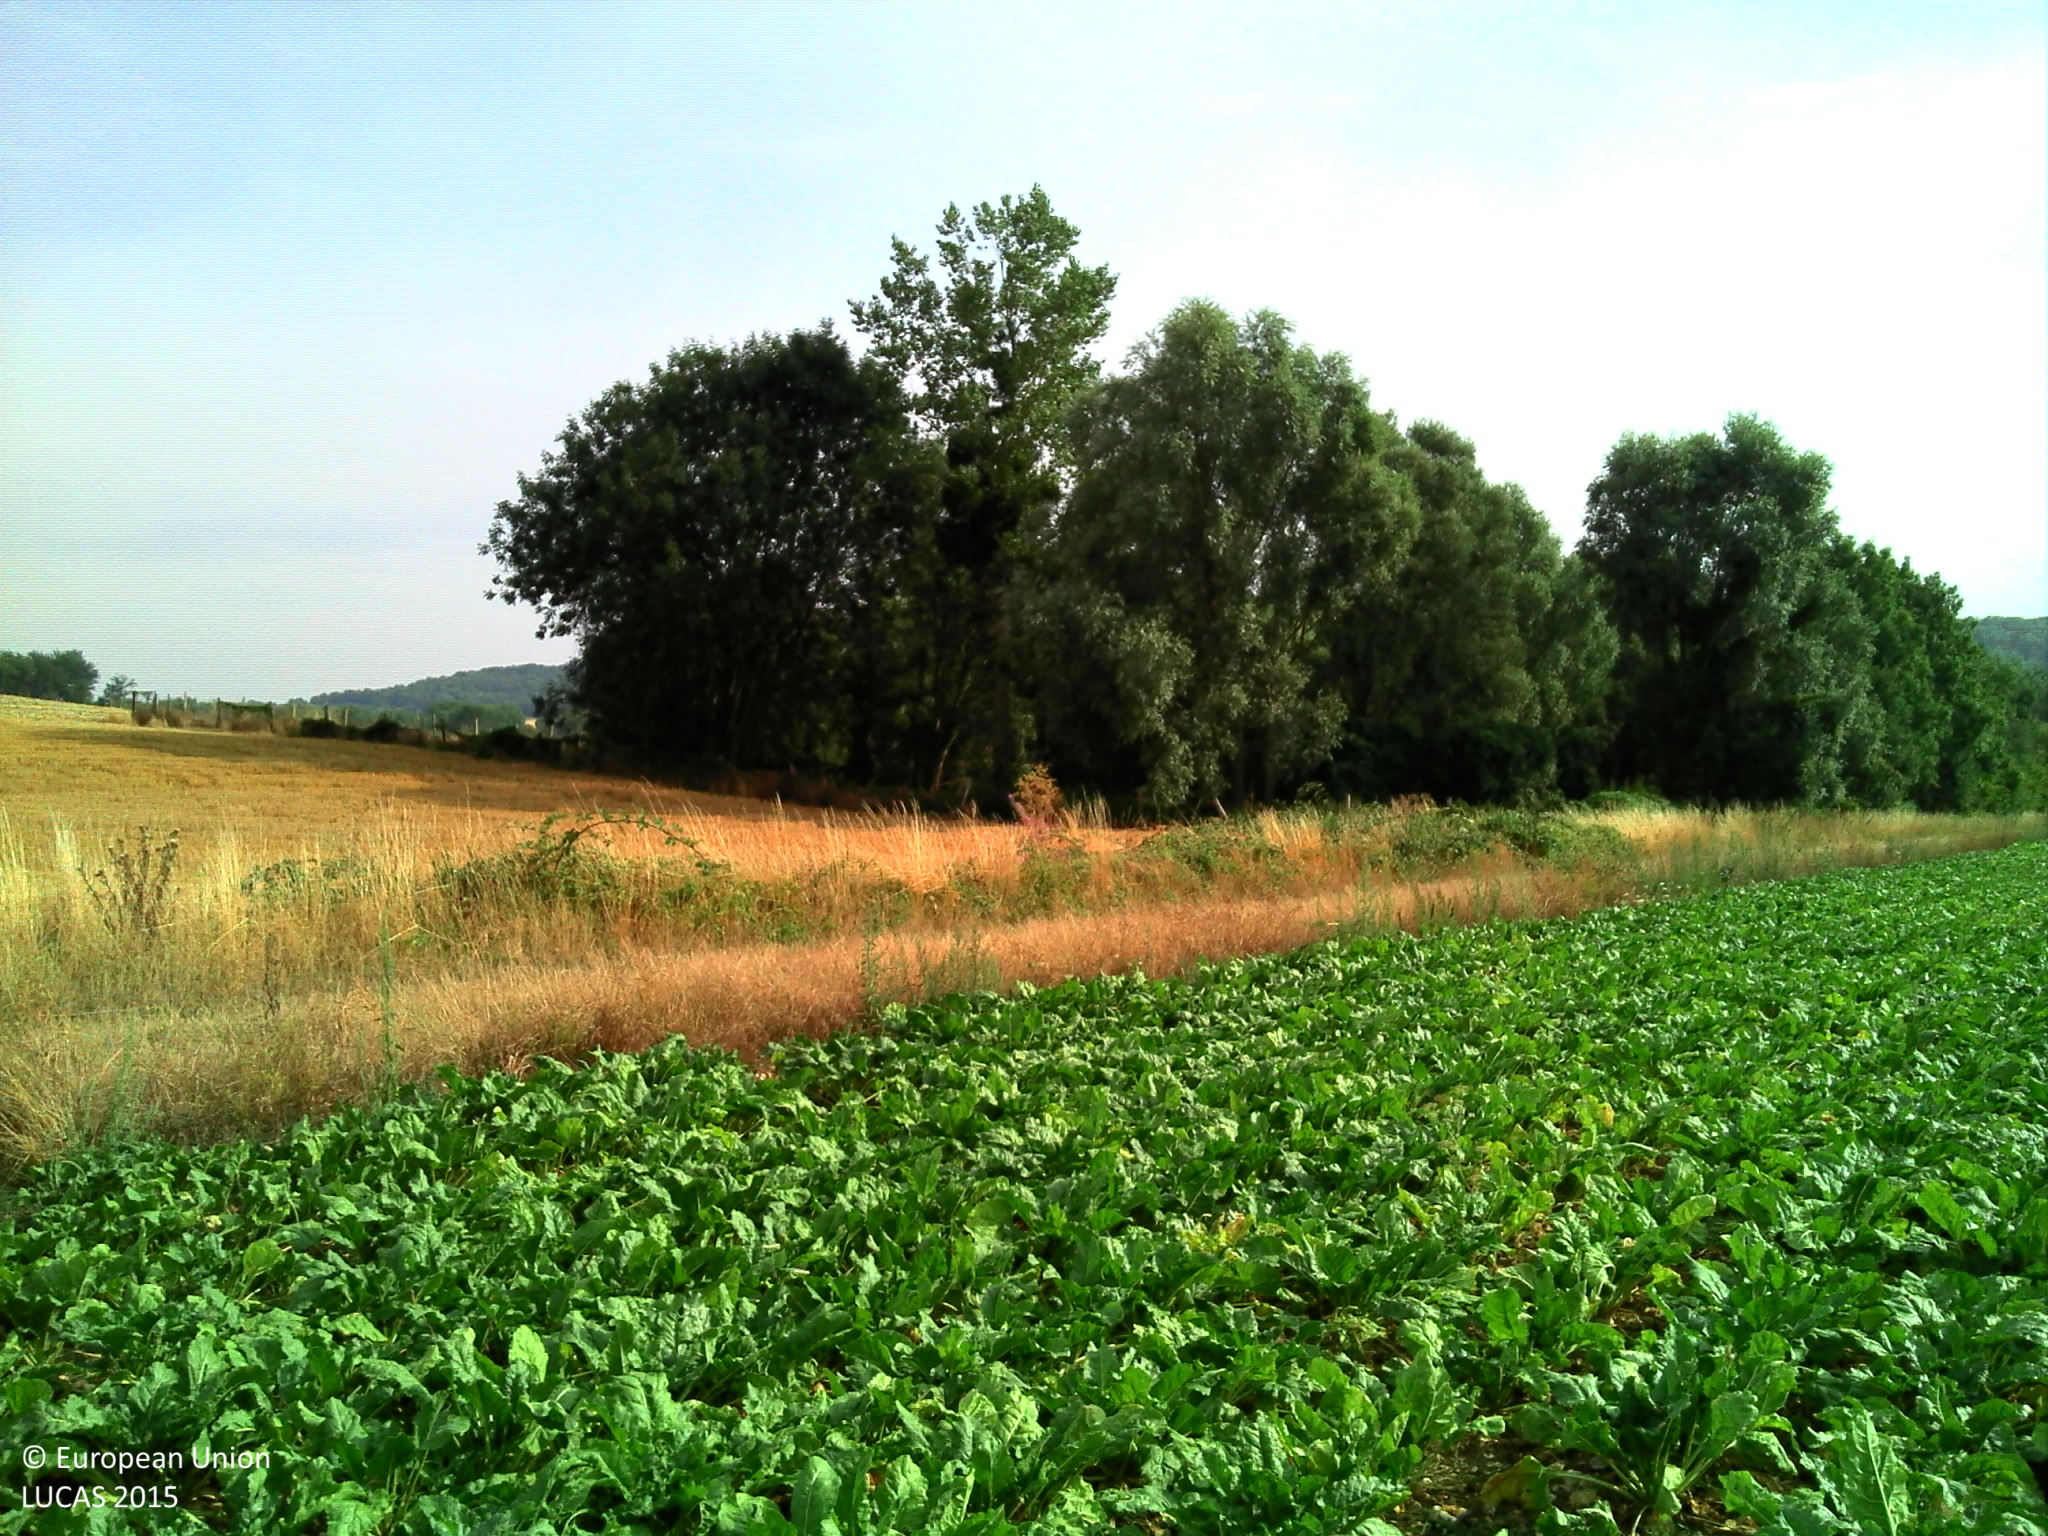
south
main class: Cropland
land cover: Sugar beet
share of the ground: > 75 %
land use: Agriculture (excluding fallow land and kitchen gardens)
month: August
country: FR
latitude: 49.2711
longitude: 3.7129
